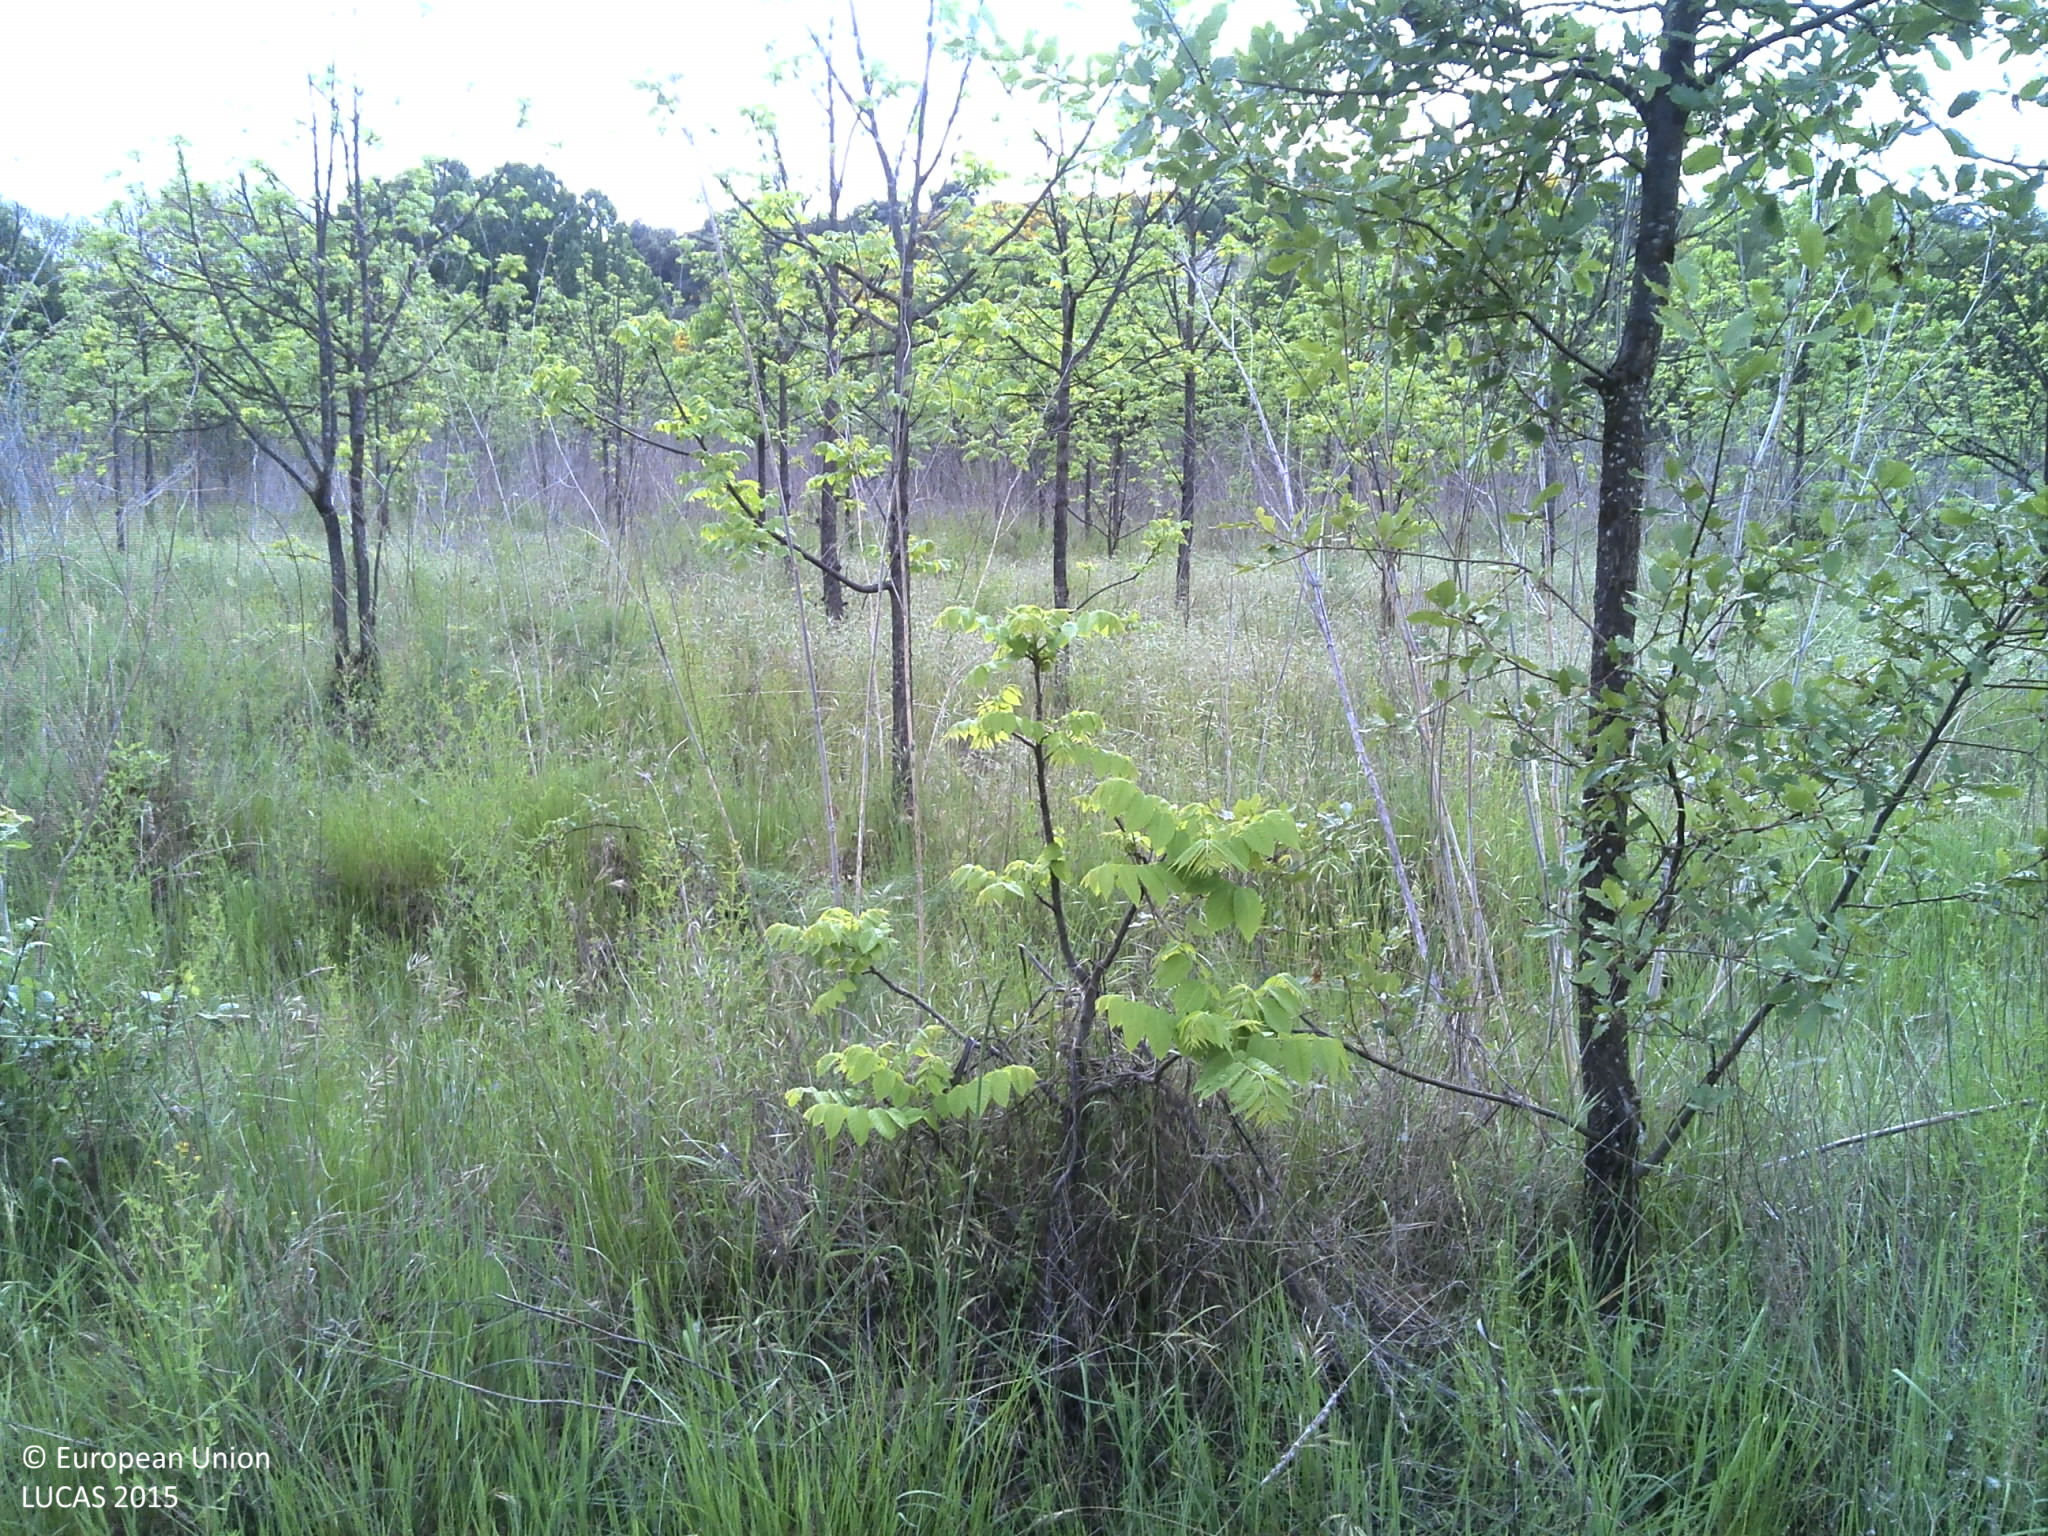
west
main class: Woodland
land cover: Broadleaved woodland
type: exotic forest
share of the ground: 10 - 25 %
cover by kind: herbaceous plants 70 %, broadleaved forest trees 20 %, unconsolidated bare surface 10 %
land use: Forestry
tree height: < 5 m
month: May
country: PT
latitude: 41.6380
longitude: -7.1556
